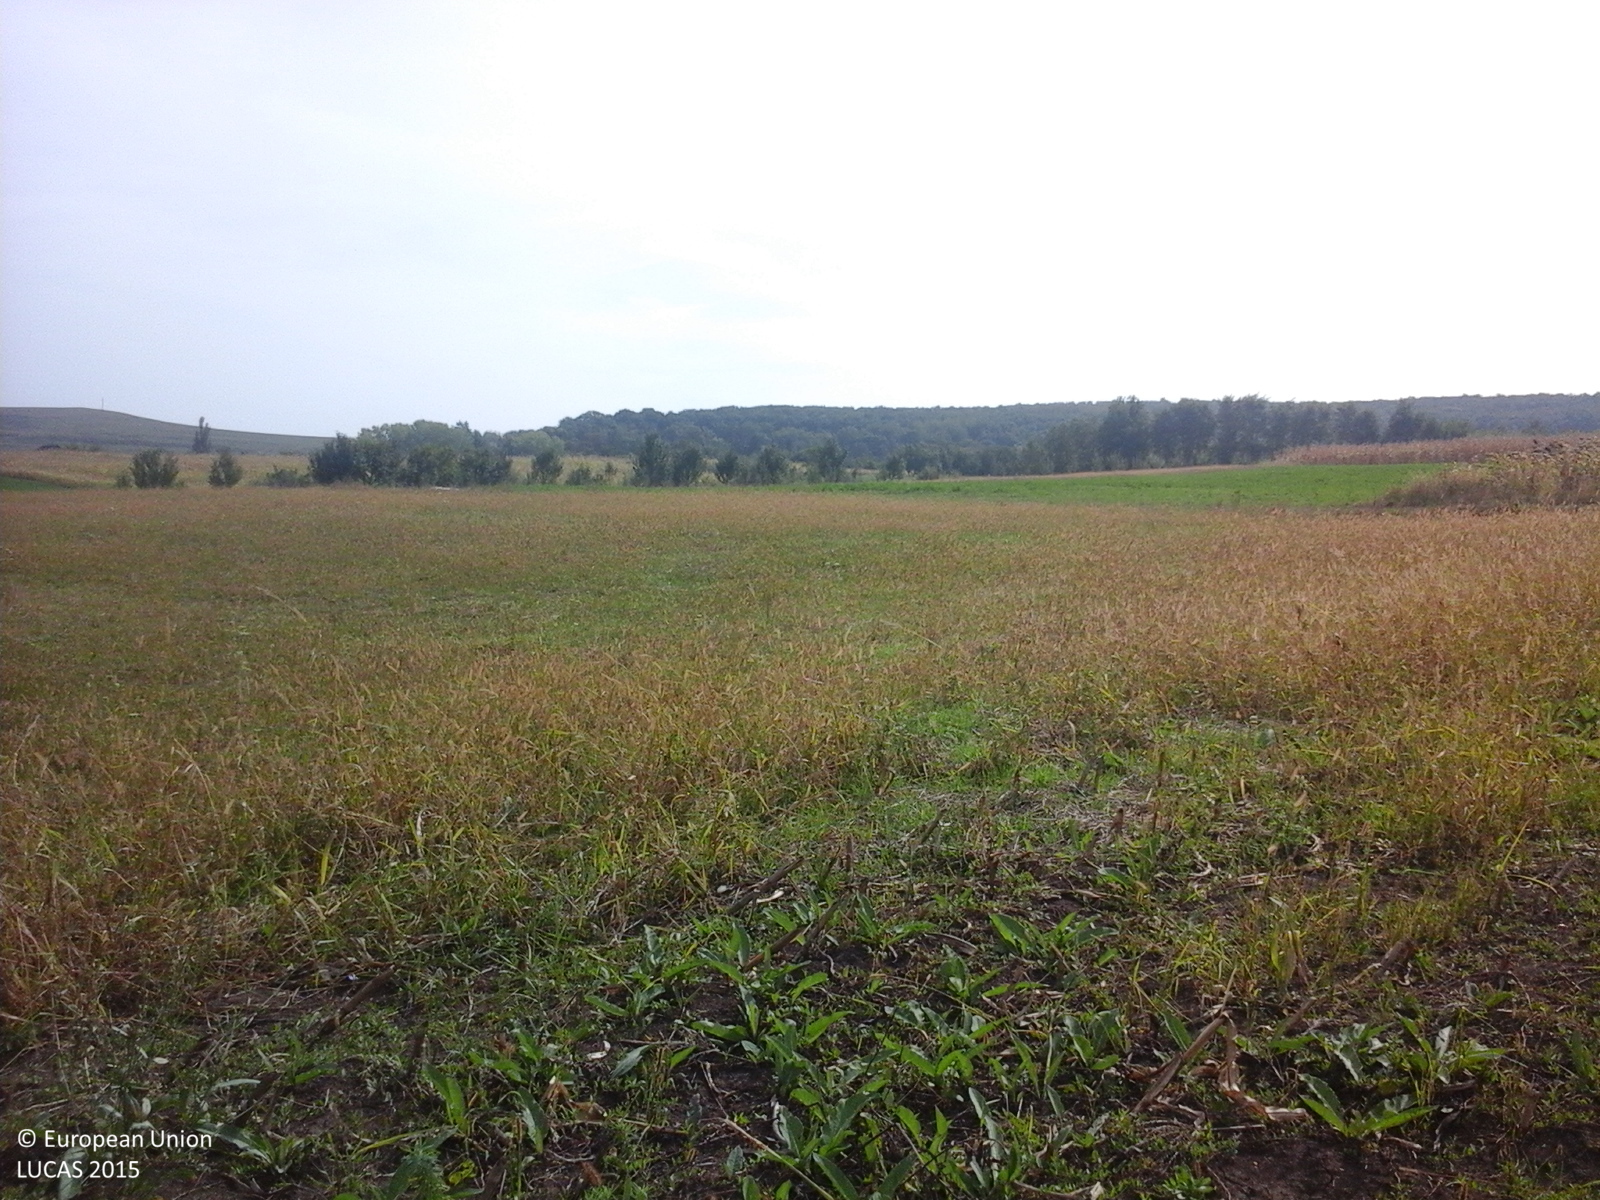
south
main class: Cropland
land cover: Maize
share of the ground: > 75 %
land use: Agriculture (excluding fallow land and kitchen gardens)
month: September
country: RO
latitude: 46.8478
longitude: 24.1535
